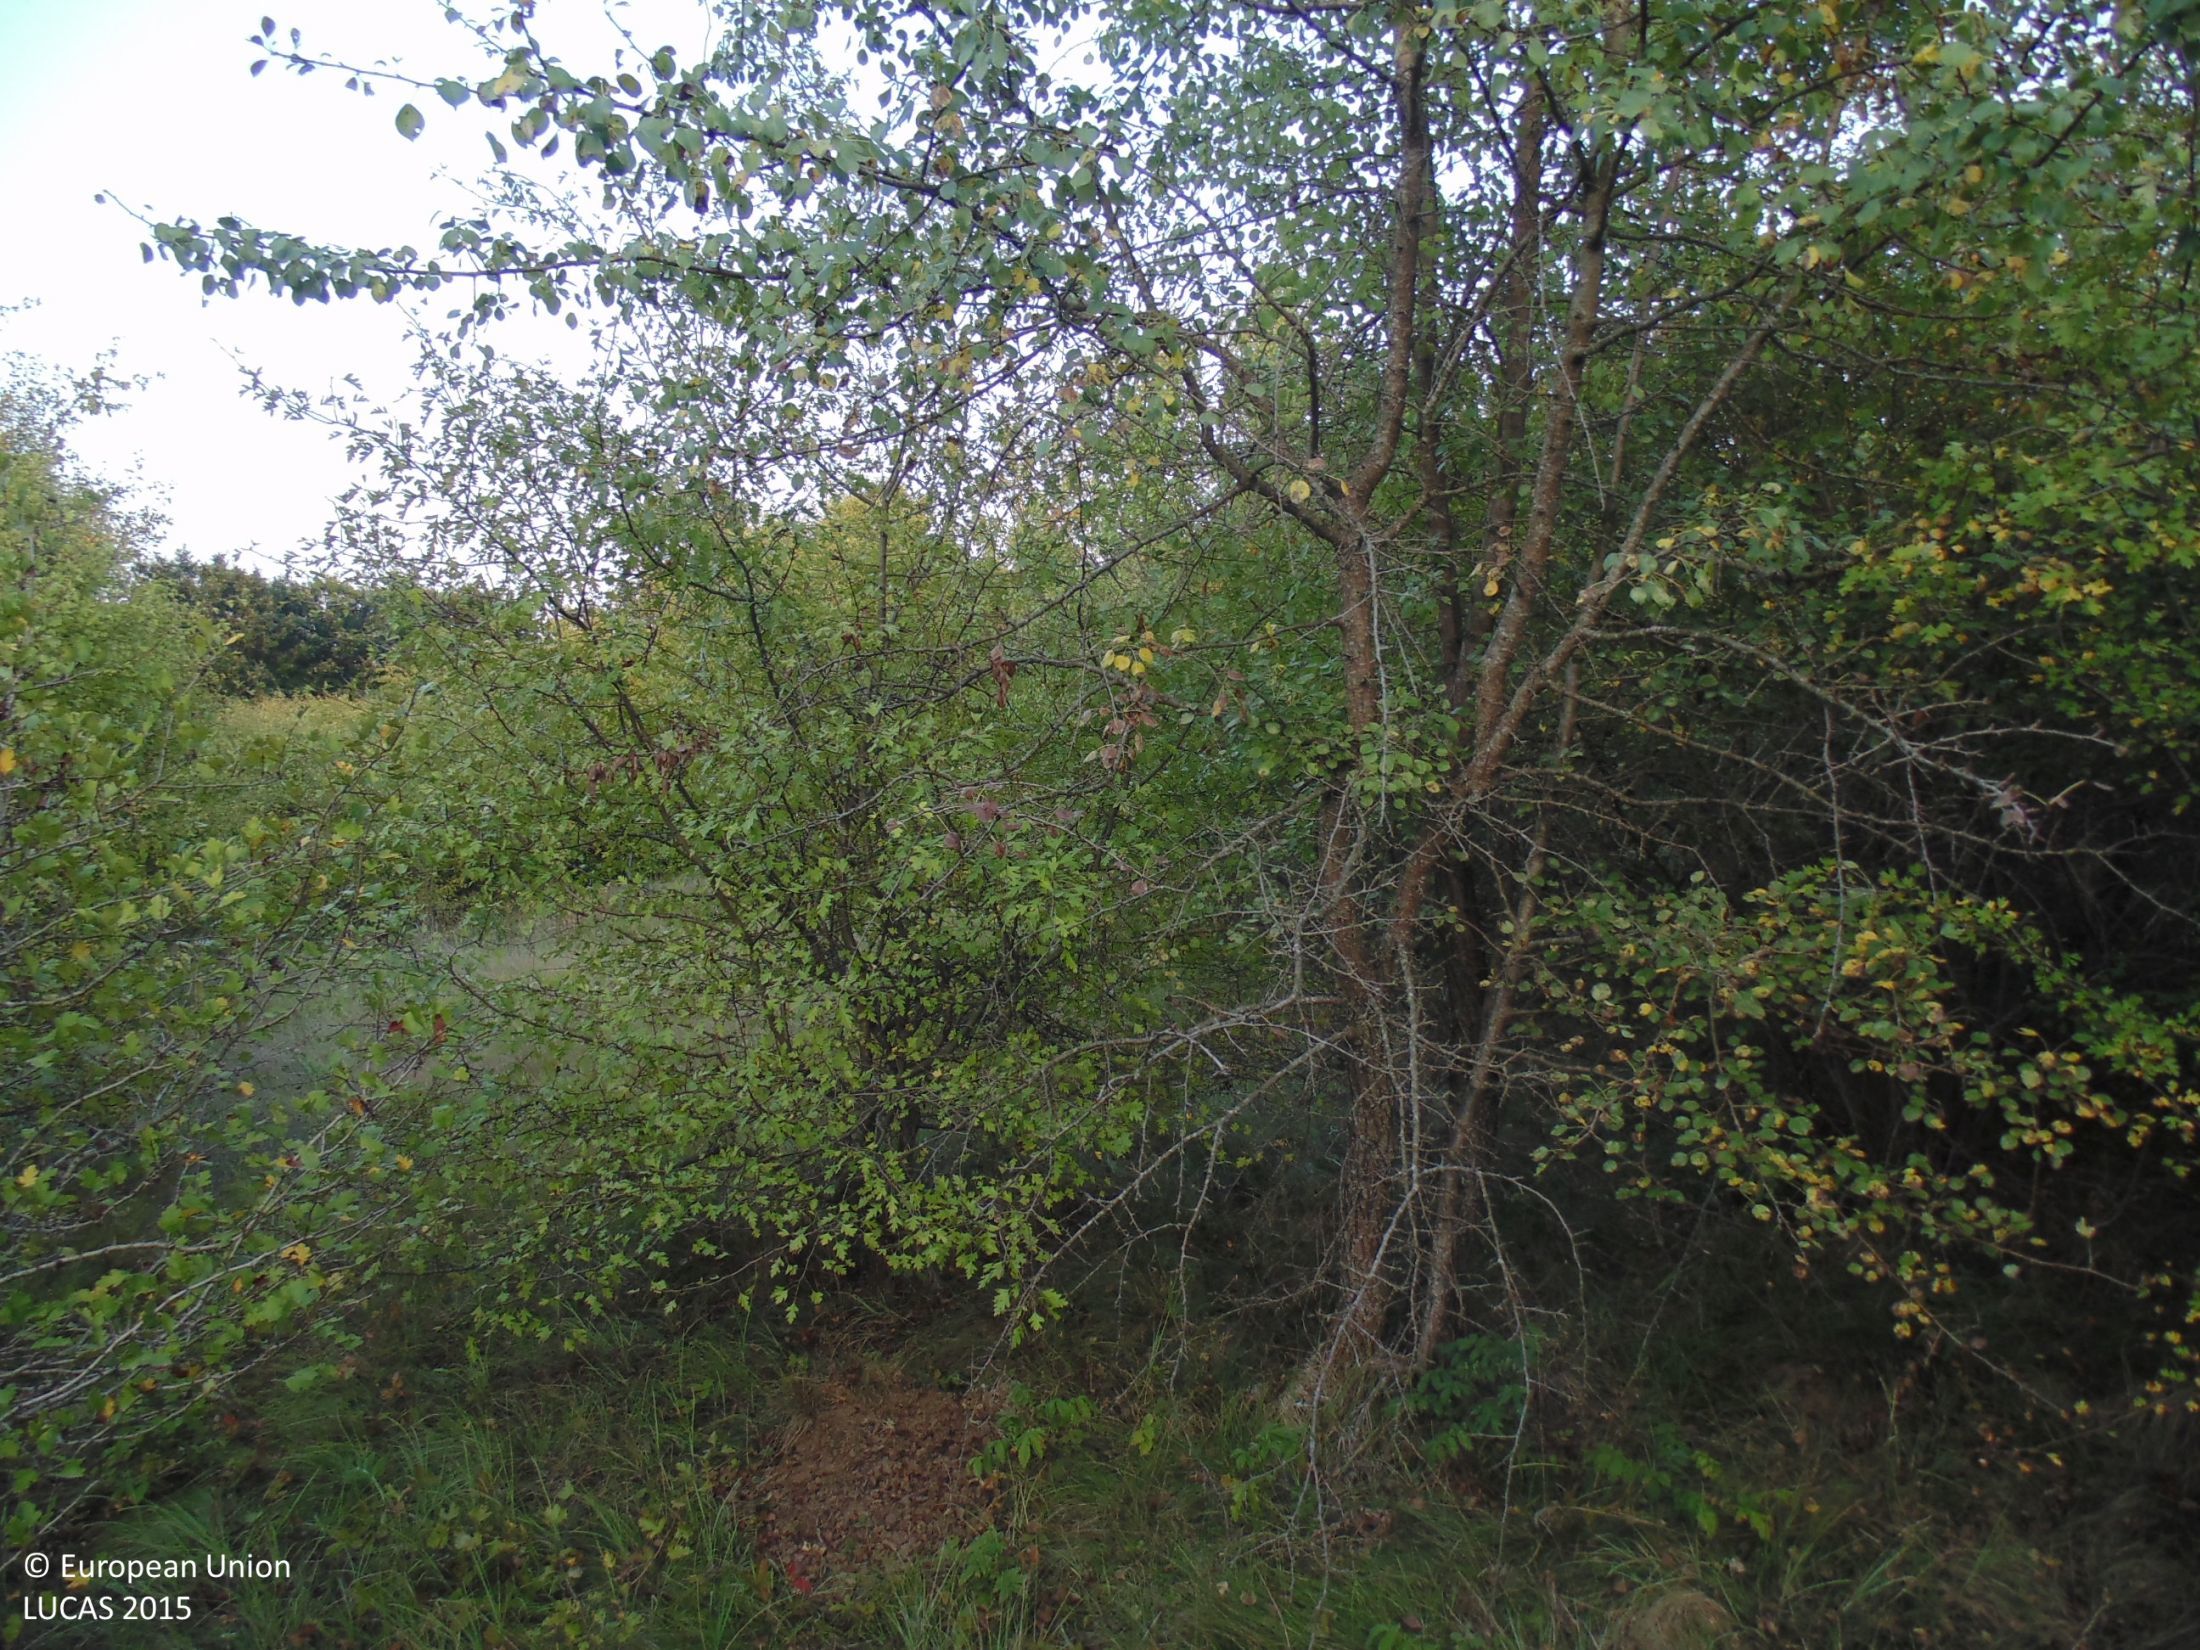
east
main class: Woodland
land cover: Broadleaved woodland
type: mesophytic deciduous forest
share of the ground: > 75 %
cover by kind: broadleaved forest trees 70 %, shrubs 20 %, herbaceous plants 10 %
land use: Forestry
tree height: < 5 m
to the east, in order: Broadleaved woodland; Tracks; Shrubland without tree cover; Tracks; Broadleaved woodland
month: August
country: BG
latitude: 43.8971
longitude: 27.2979
